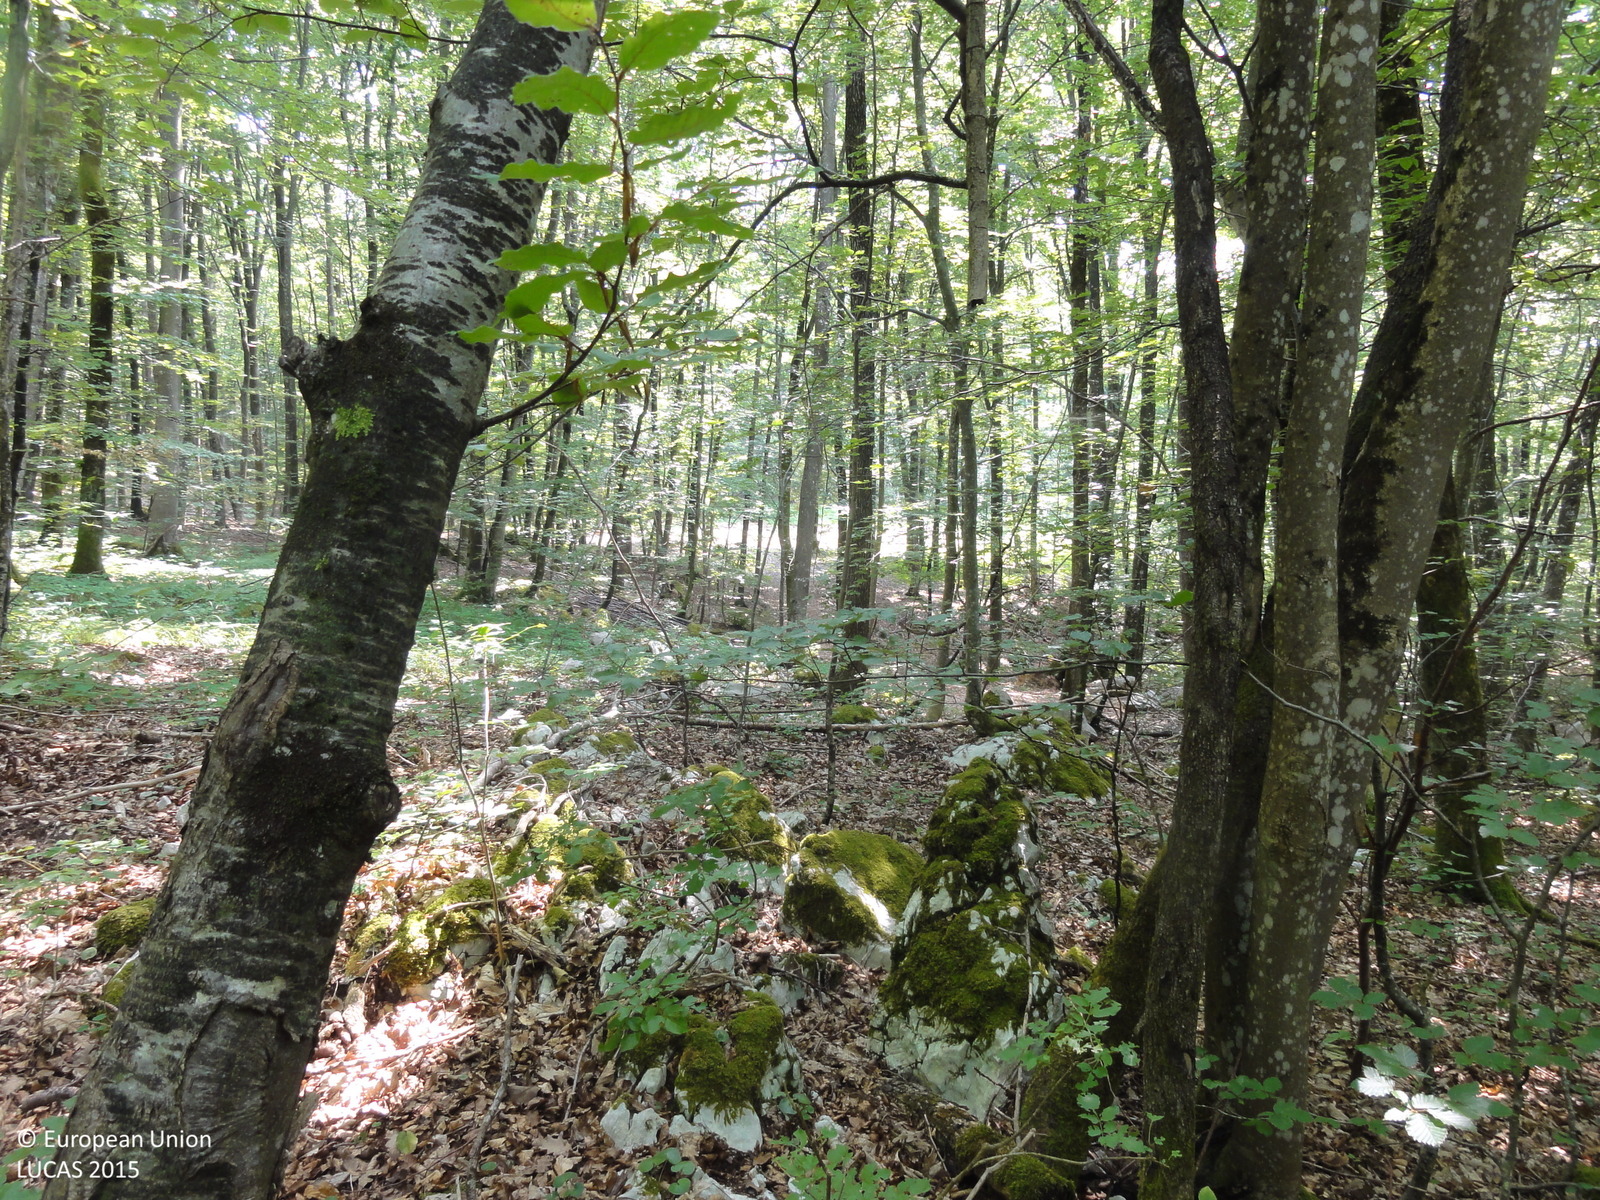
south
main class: Woodland
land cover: Broadleaved woodland
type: beech forest
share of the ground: > 75 %
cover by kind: broadleaved forest trees 100 %
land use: Forestry
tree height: > 5 m
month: July
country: SI
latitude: 45.8454
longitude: 14.8250
